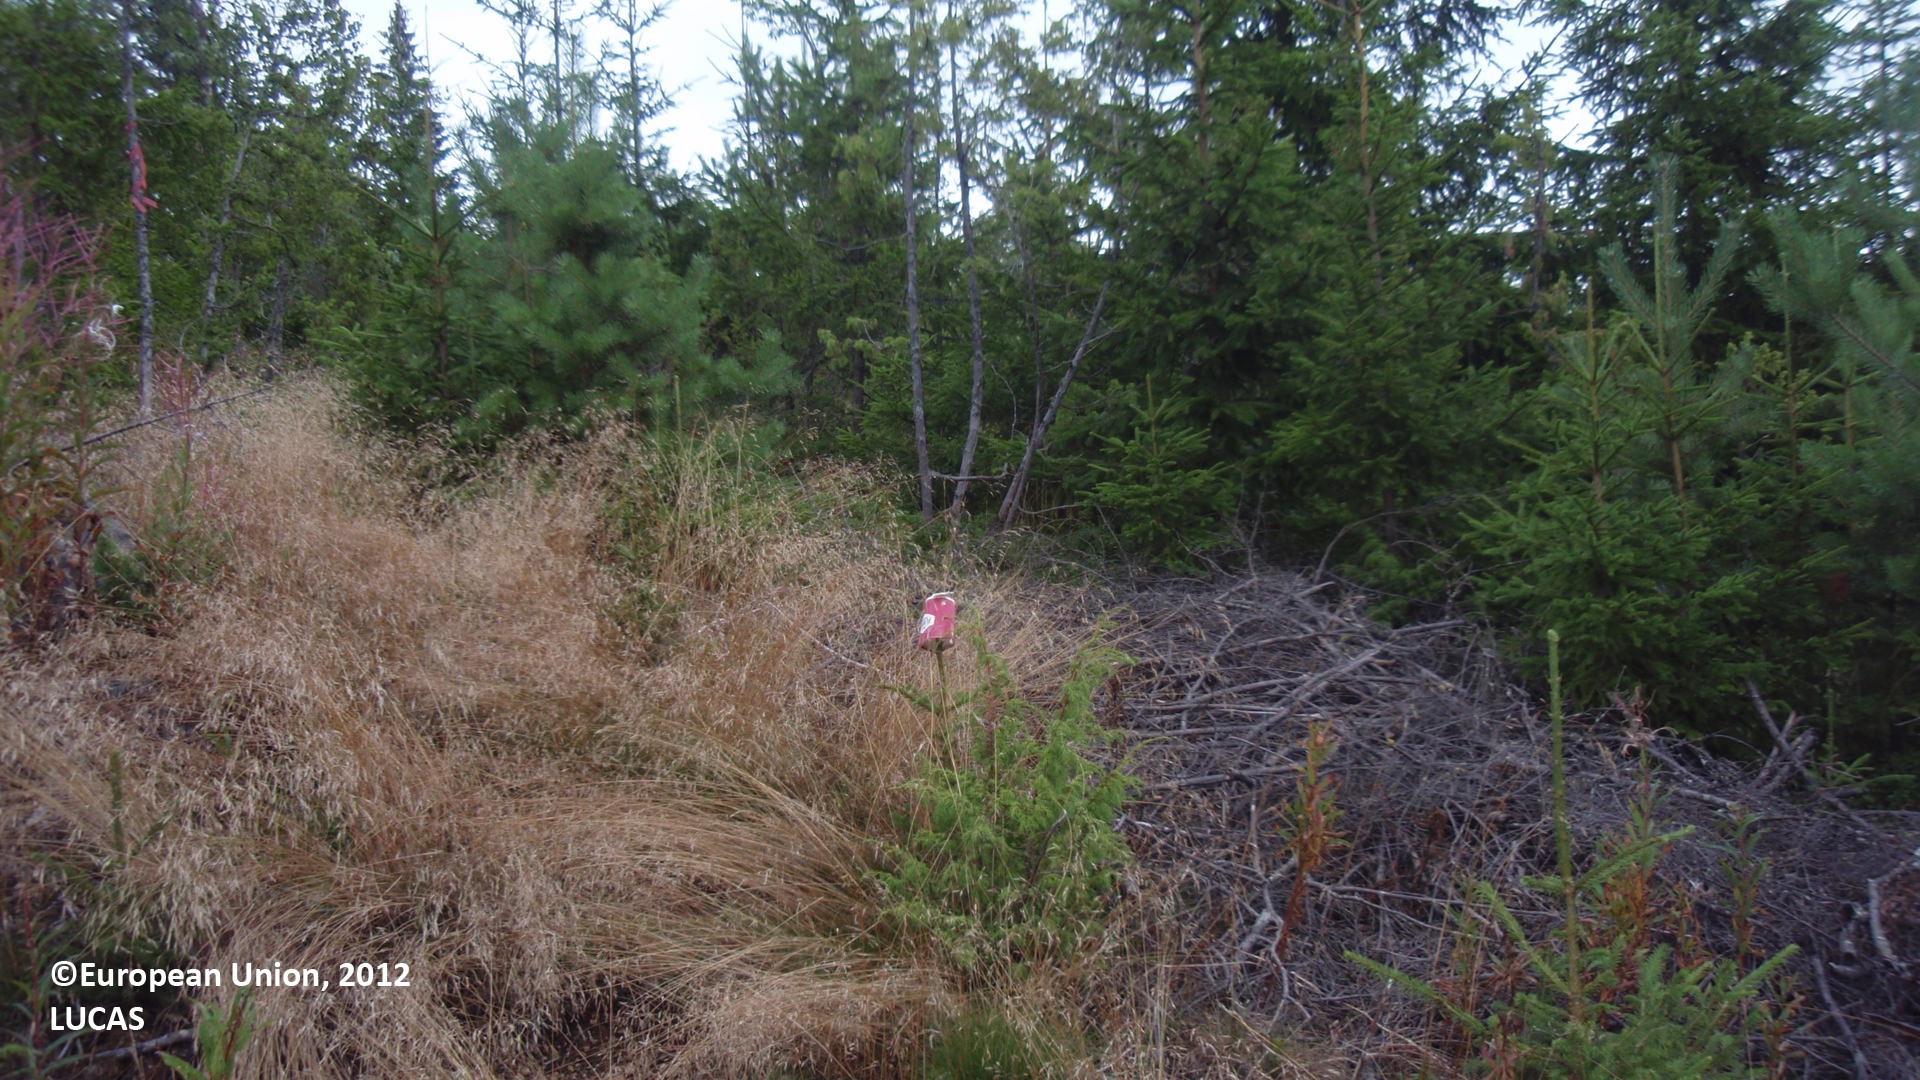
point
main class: Woodland
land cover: Other coniferous woodland
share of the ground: 10 - 25 %
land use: Forestry
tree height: < 5 m
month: August
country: FI
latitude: 61.0632
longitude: 27.5818
